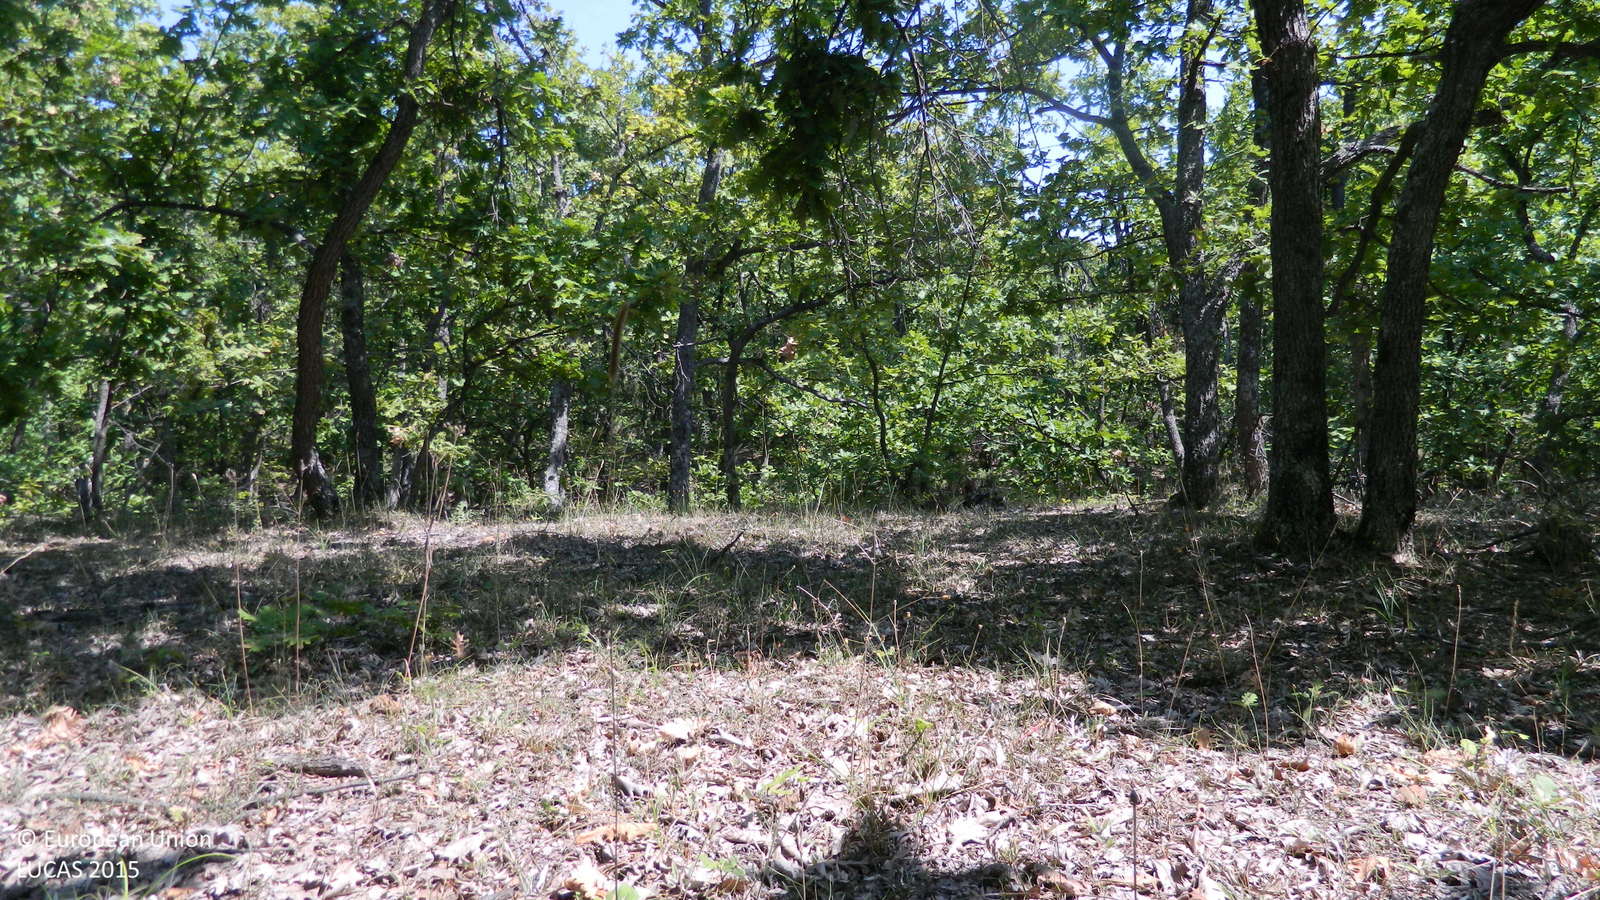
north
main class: Woodland
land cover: Broadleaved woodland
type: thermophilous deciduous forest
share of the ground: > 75 %
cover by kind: broadleaved forest trees 85 %, herbaceous plants 10 %, unconsolidated bare surface 5 %
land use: Forestry
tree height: > 5 m
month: September
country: BG
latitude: 41.6829
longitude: 25.6686
